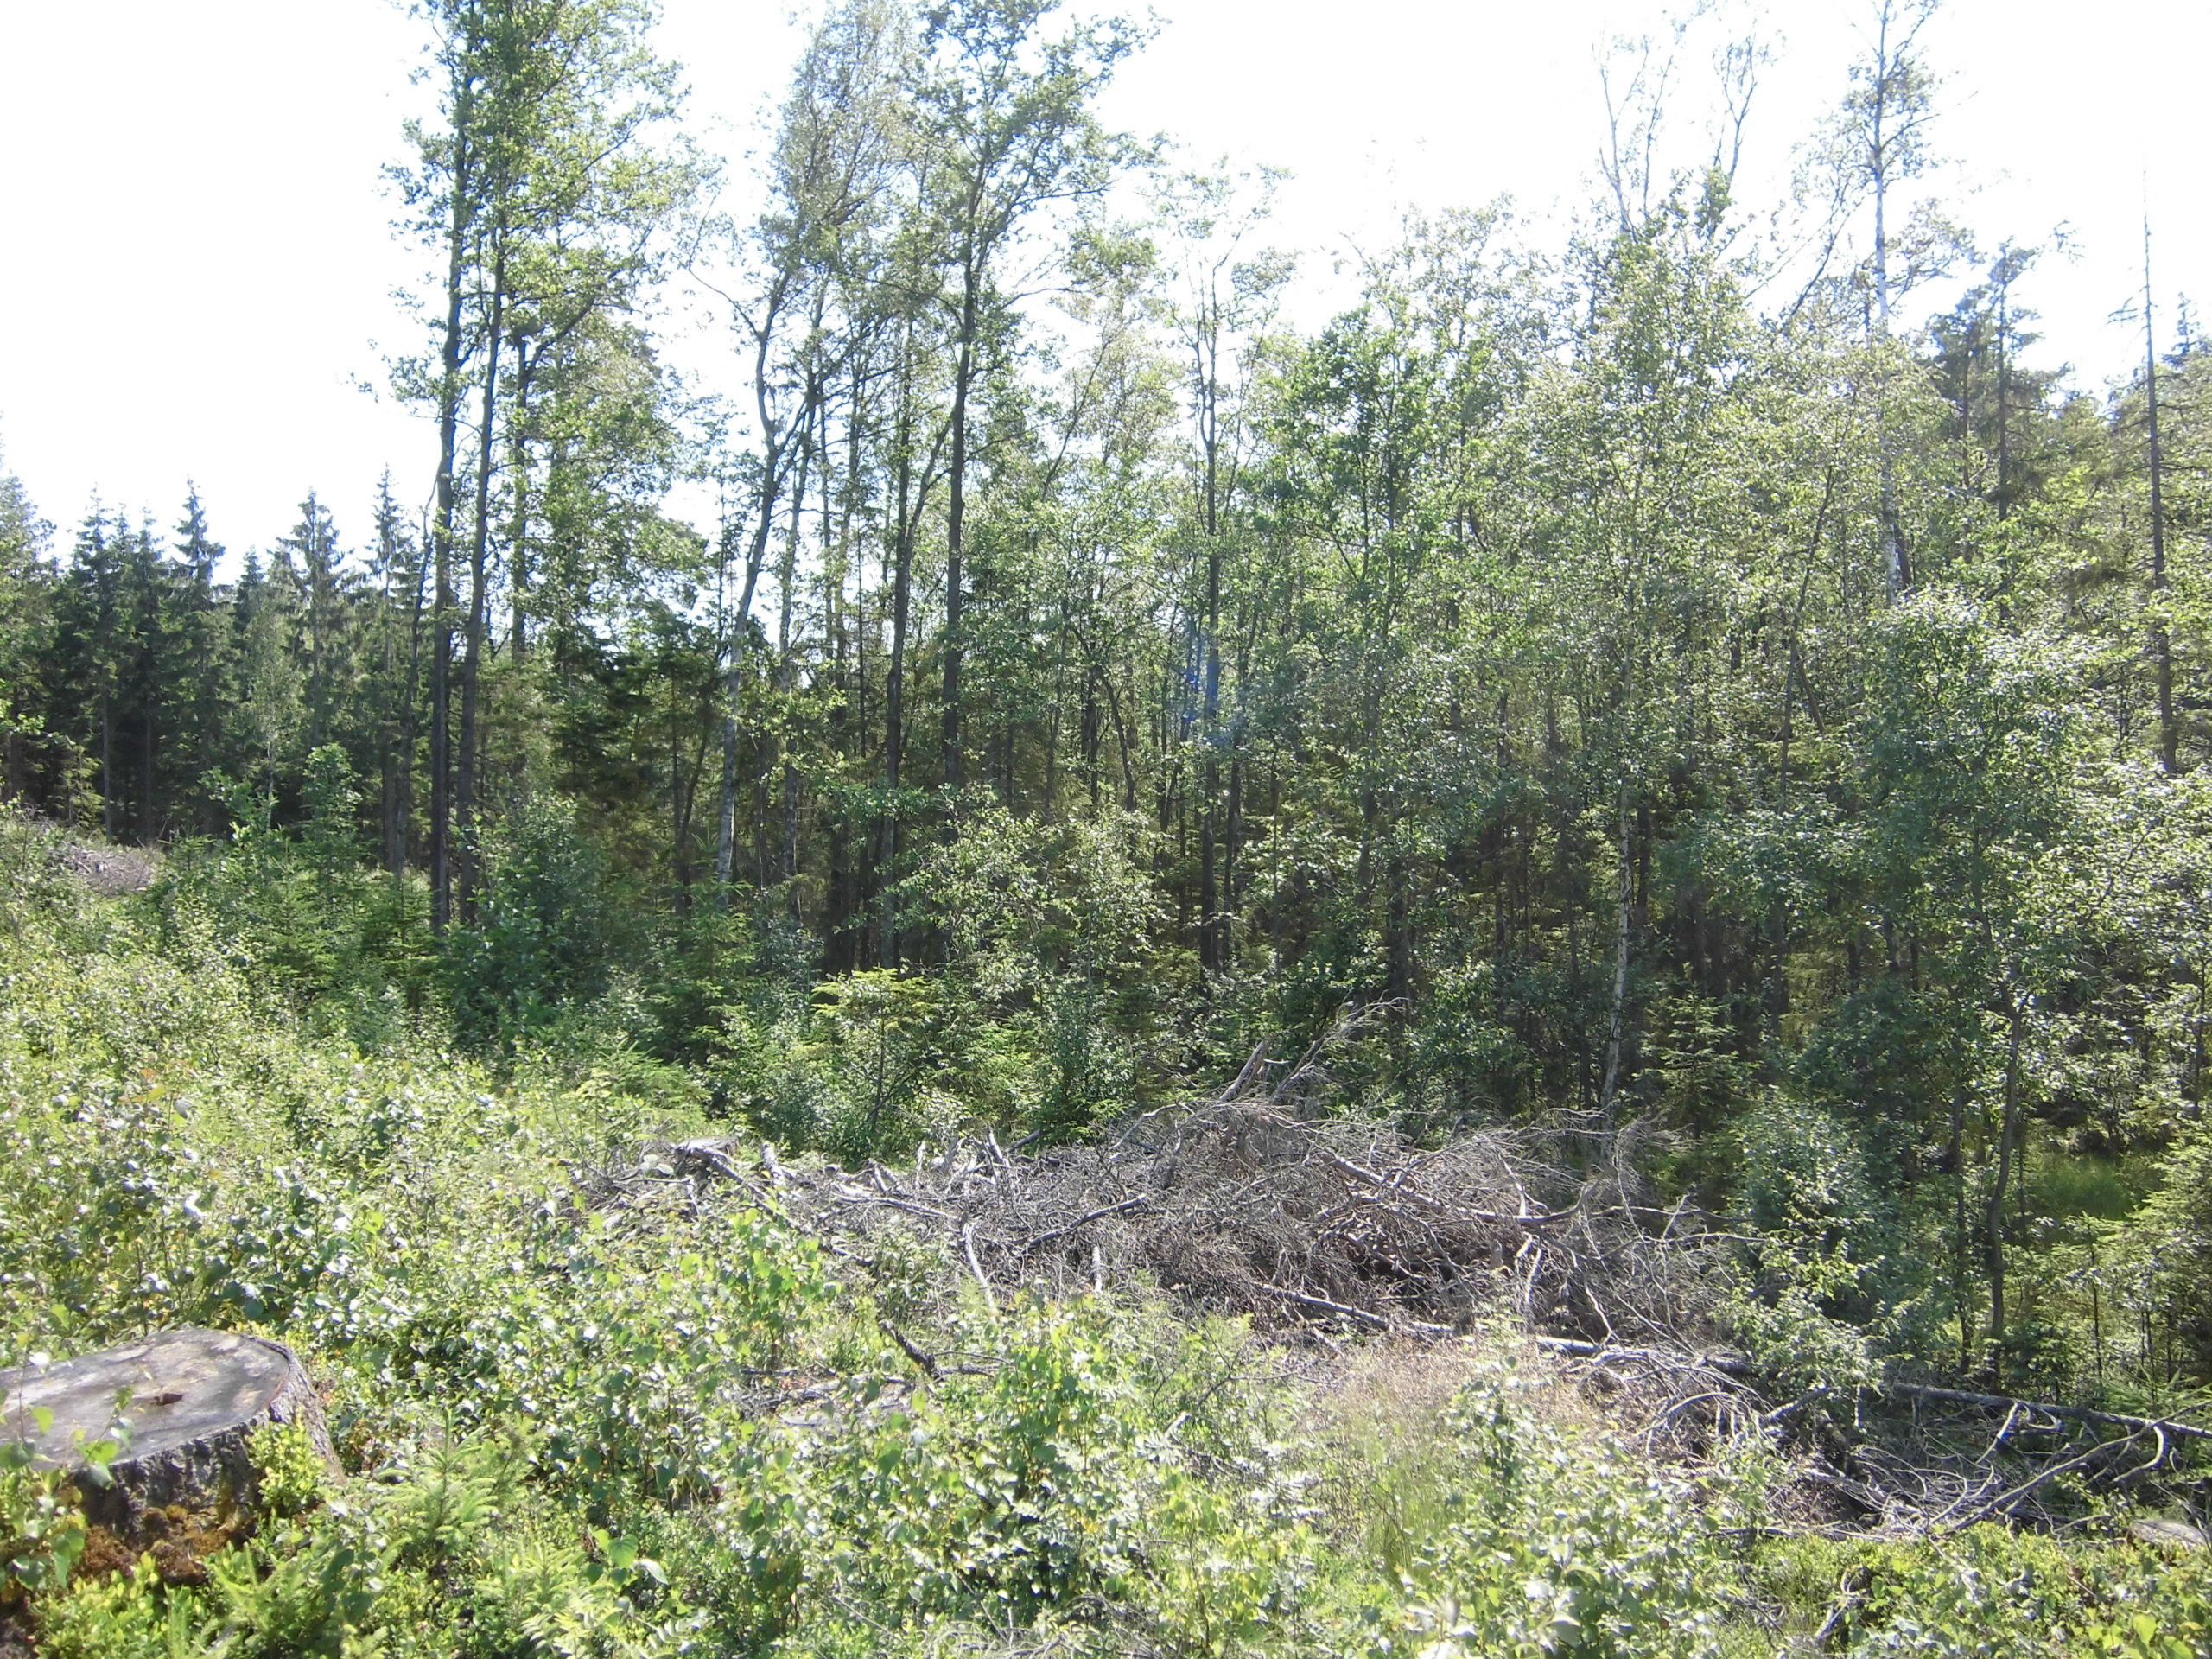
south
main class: Woodland
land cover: Spruce dominated mixed woodland
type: boreal forest
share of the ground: 25 - 50 %
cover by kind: coniferous forest trees 25 %, broadleaved forest trees 25 %, shrubs 25 %, herbaceous plants 15 %, lichens and mosses 10 %
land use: Forestry
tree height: < 5 m
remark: Clear cut
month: July
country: SE
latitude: 57.2652
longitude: 14.3900
